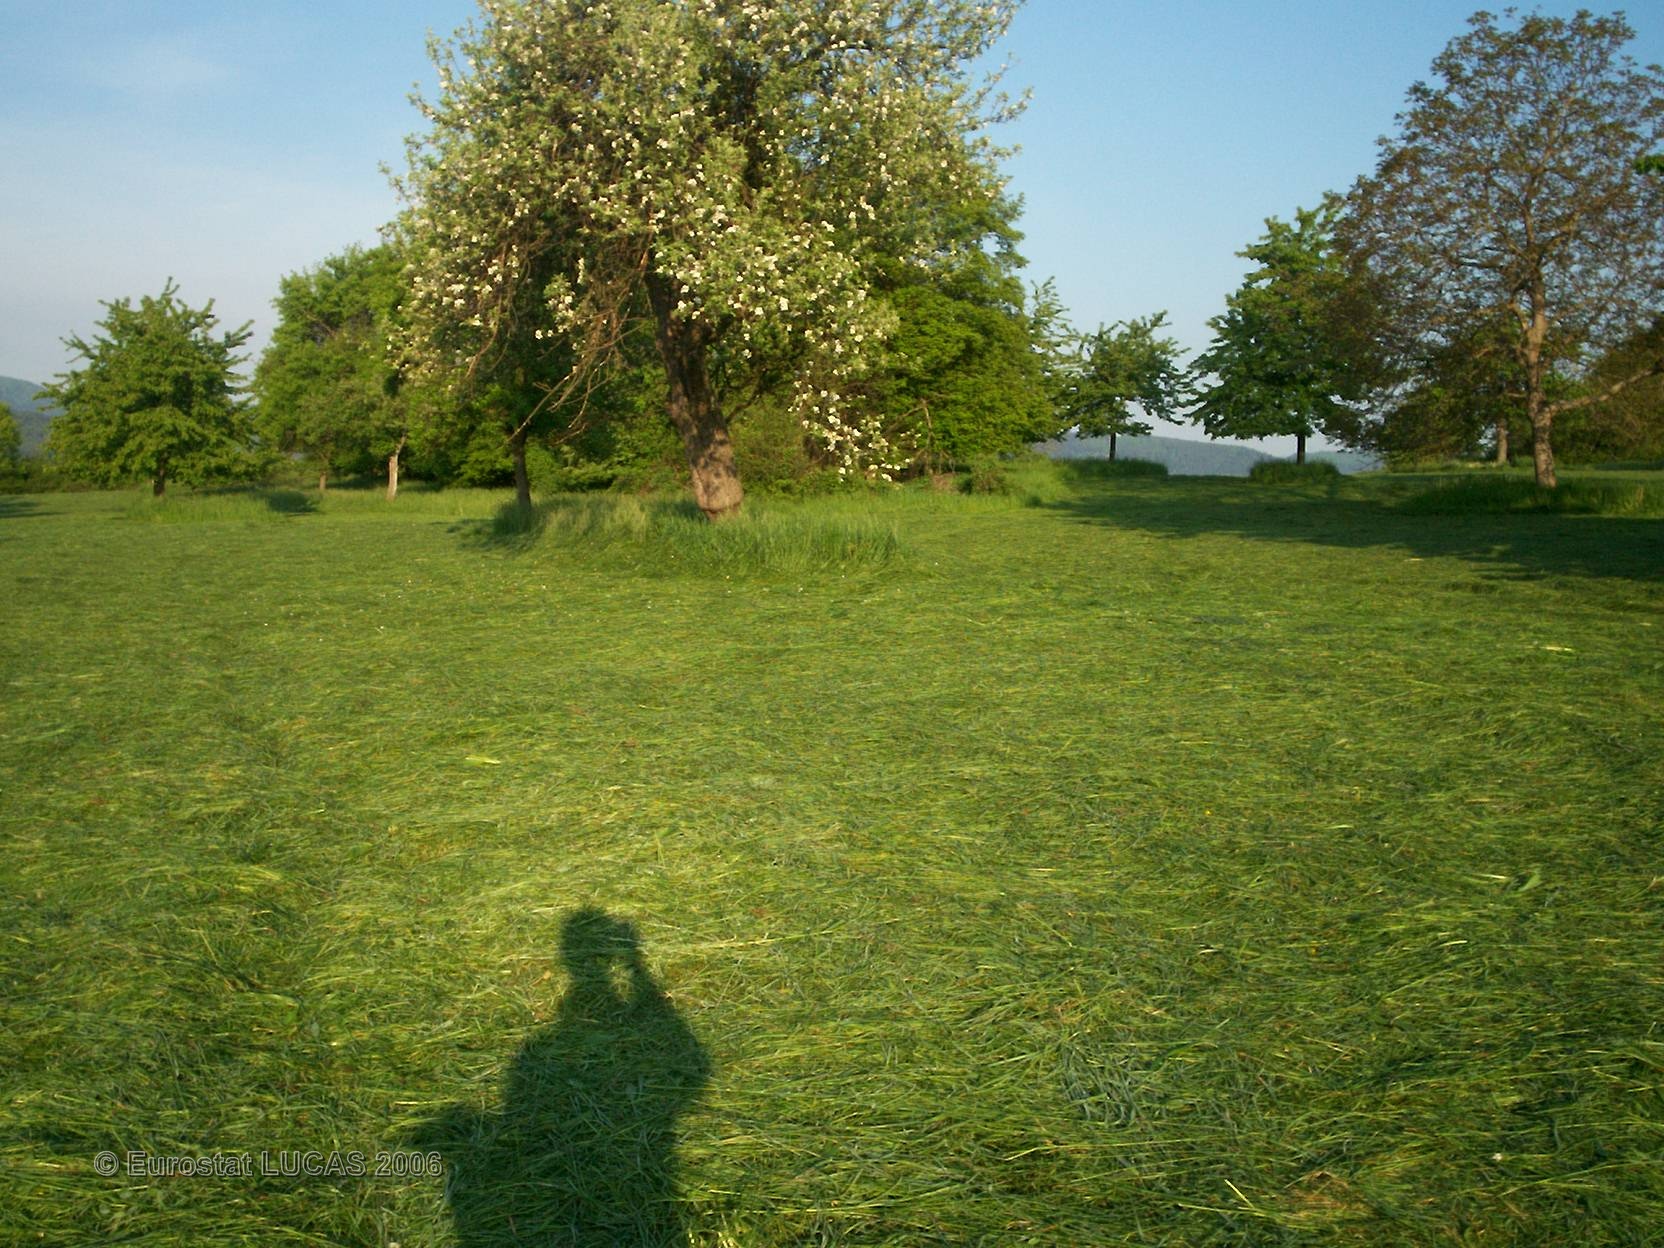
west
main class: Grassland
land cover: Grassland with sparse tree/shrub cover
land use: Agriculture (excluding fallow land and kitchen gardens)
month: May
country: FR
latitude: 48.6605
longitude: 7.3804
